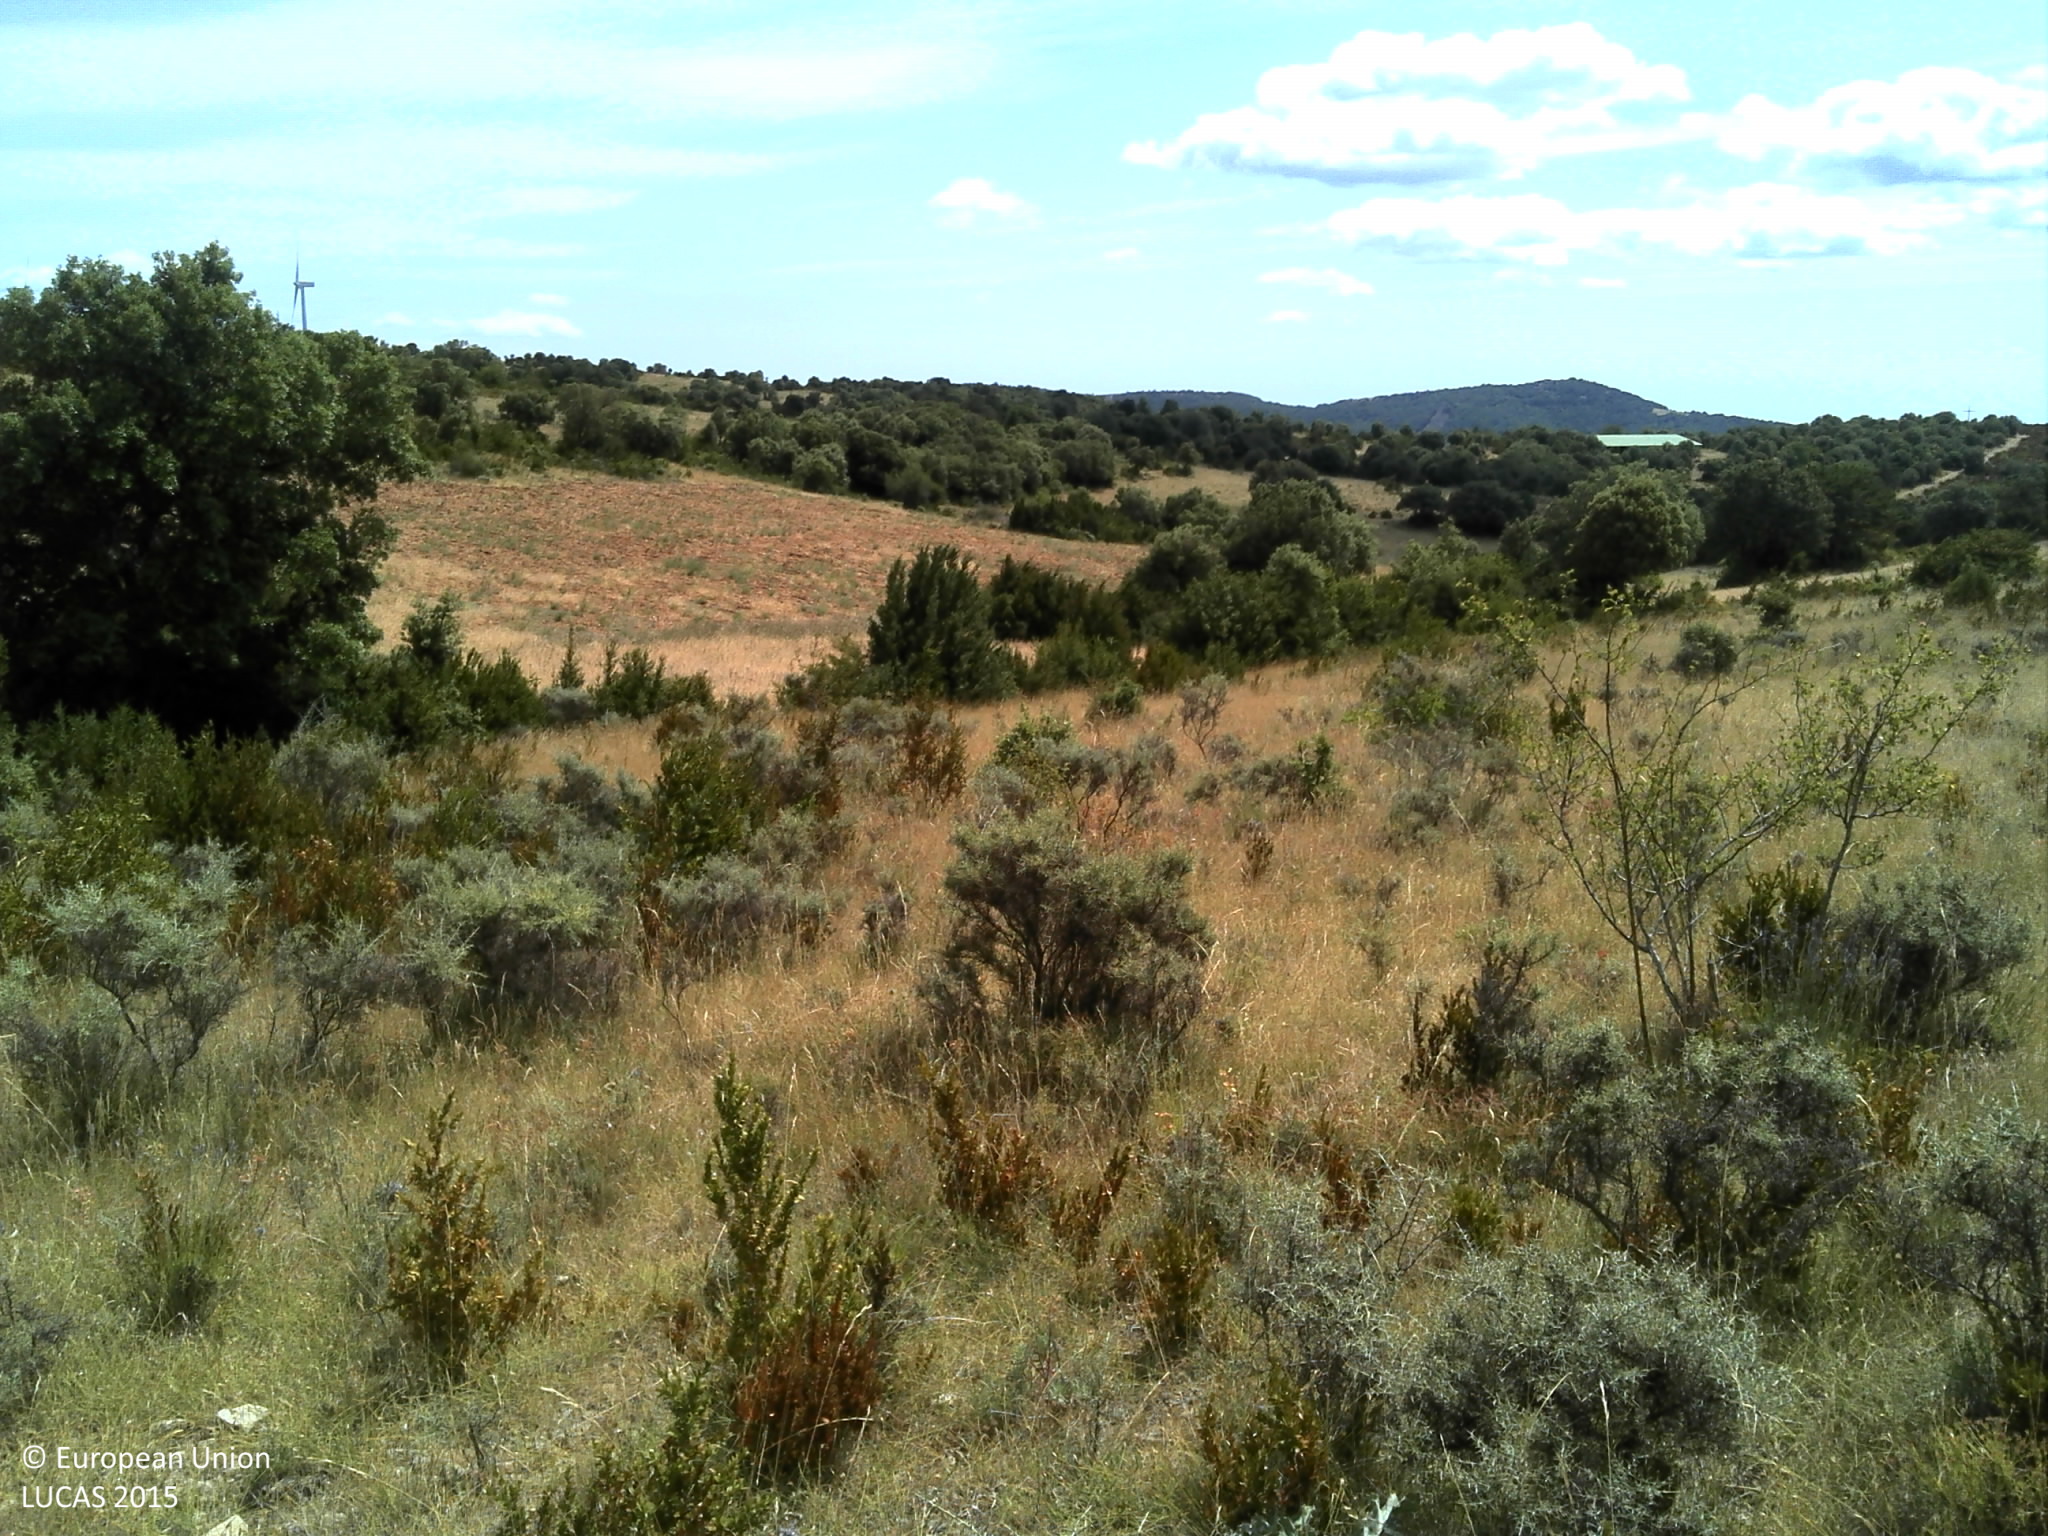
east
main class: Shrubland
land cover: Shrubland without tree cover
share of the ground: > 75 %
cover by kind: herbaceous plants 60 %, shrubs 20 %, consolidated bare surface 15 %, unconsolidated bare surface 5 %
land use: Semi-natural and natural areas not in use
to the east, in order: Shrubland without tree cover; Lines of trees; Grassland without tree/shrub cover; Other bare soil; Grassland with sparse tree/shrub cover; Tracks; Grassland with sparse tree/shrub cover; Shrubland without tree cover; Fences; Shrubland without tree cover; Broadleaved woodland; Shrubland without tree cover
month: July
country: FR
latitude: 43.6748
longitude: 3.1985
